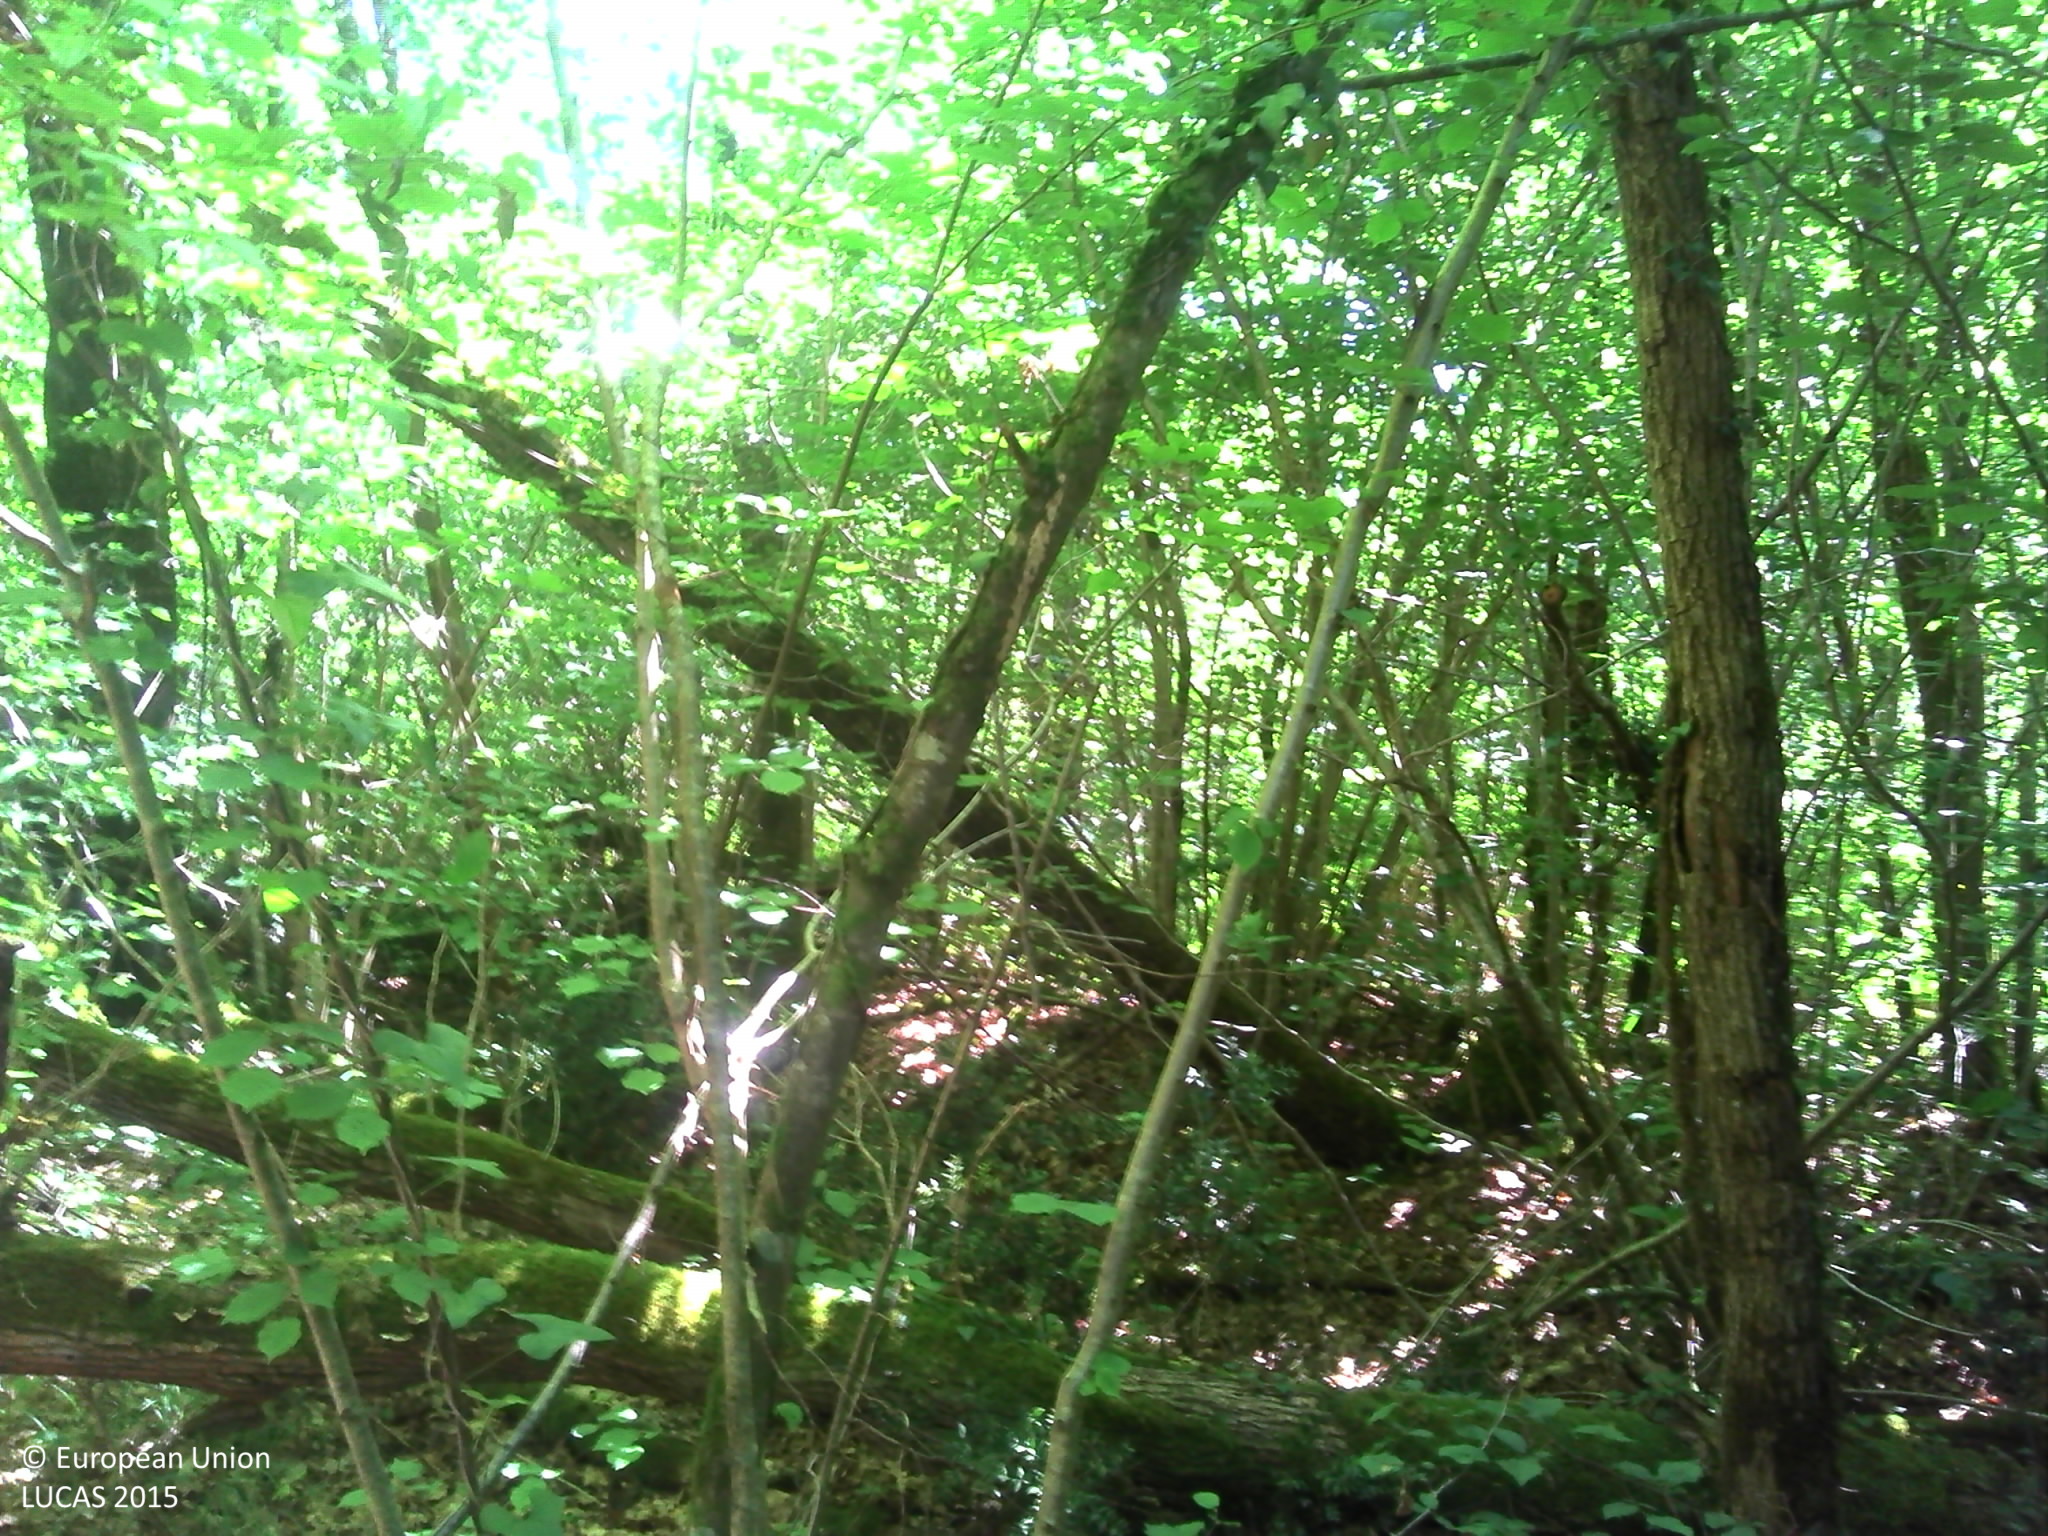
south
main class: Woodland
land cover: Broadleaved woodland
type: mesophytic deciduous forest
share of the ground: > 75 %
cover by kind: broadleaved forest trees 100 %
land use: Forestry
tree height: > 5 m
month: June
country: FR
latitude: 45.6558
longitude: -0.6367
